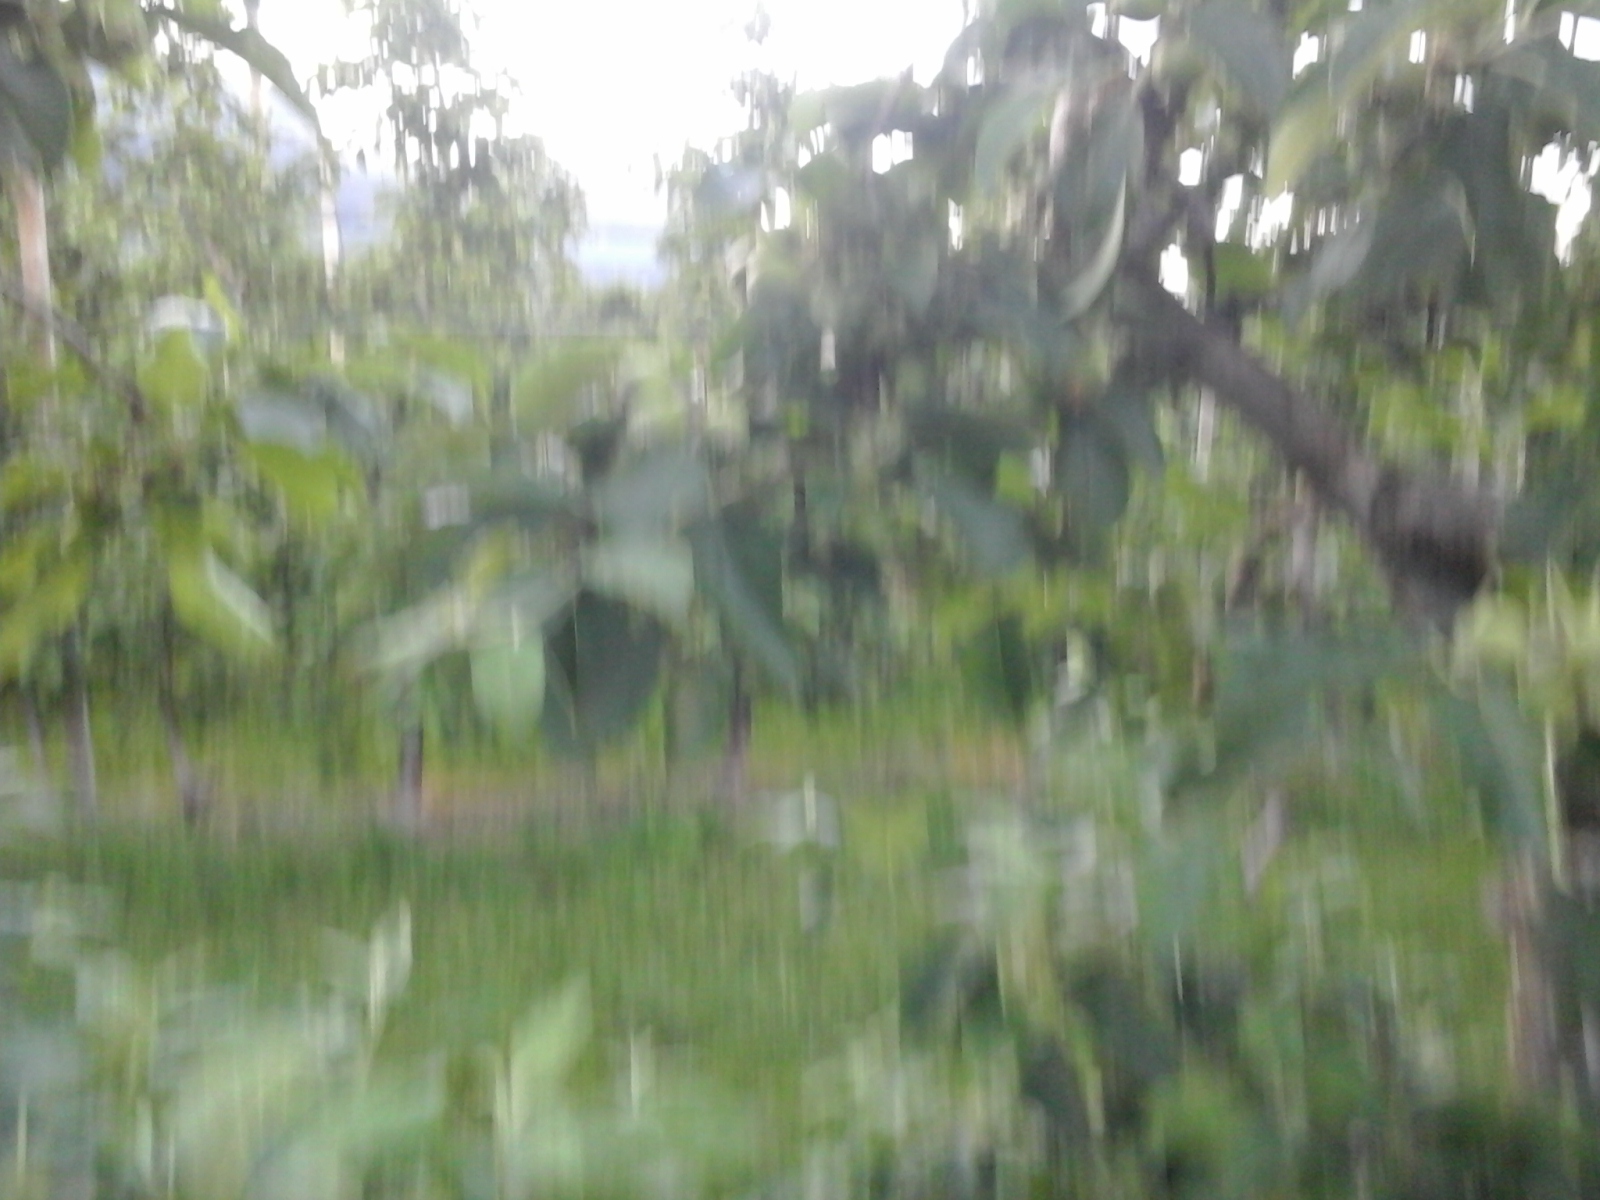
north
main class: Cropland
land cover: Apple fruit
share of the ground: 25 - 50 %
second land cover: Grassland without tree/shrub cover
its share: > 75 %
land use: Agriculture (excluding fallow land and kitchen gardens)
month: May
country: IT
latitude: 46.3618
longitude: 11.2591
